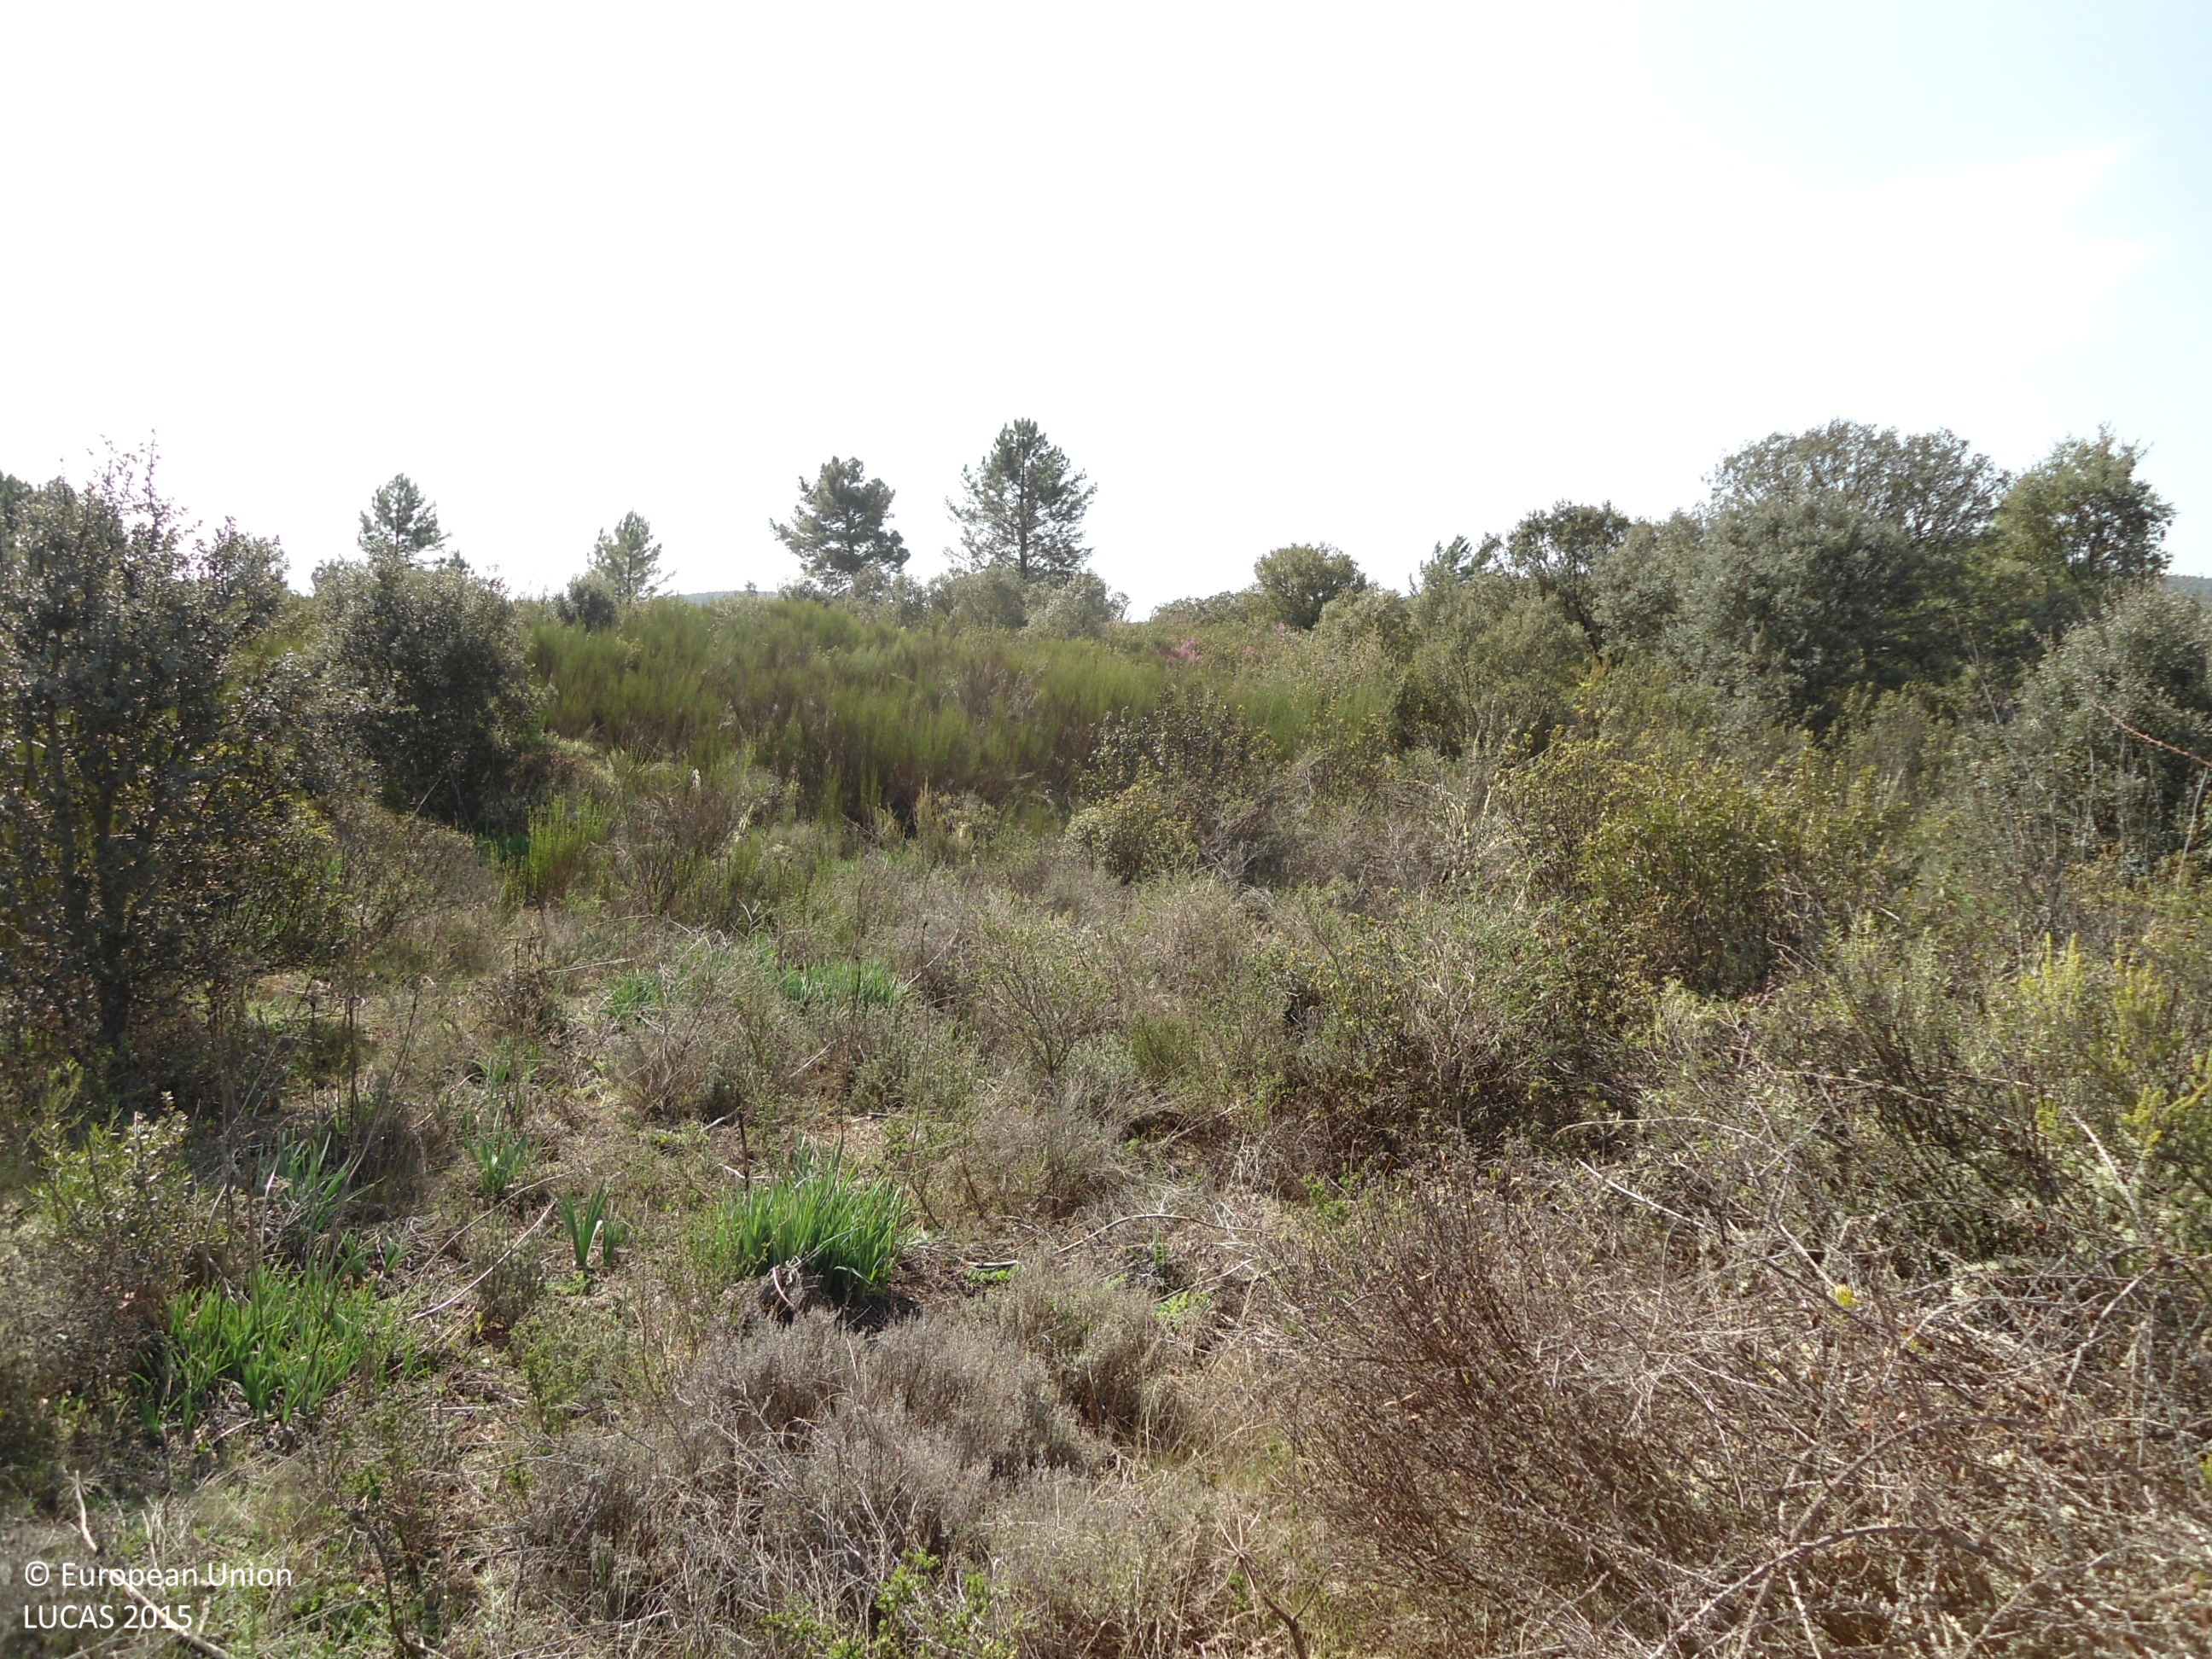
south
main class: Shrubland
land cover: Shrubland without tree cover
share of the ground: > 75 %
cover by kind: shrubs 90 %, herbaceous plants 10 %
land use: Semi-natural and natural areas not in use
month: April
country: ES
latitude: 41.7013
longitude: -6.4595
